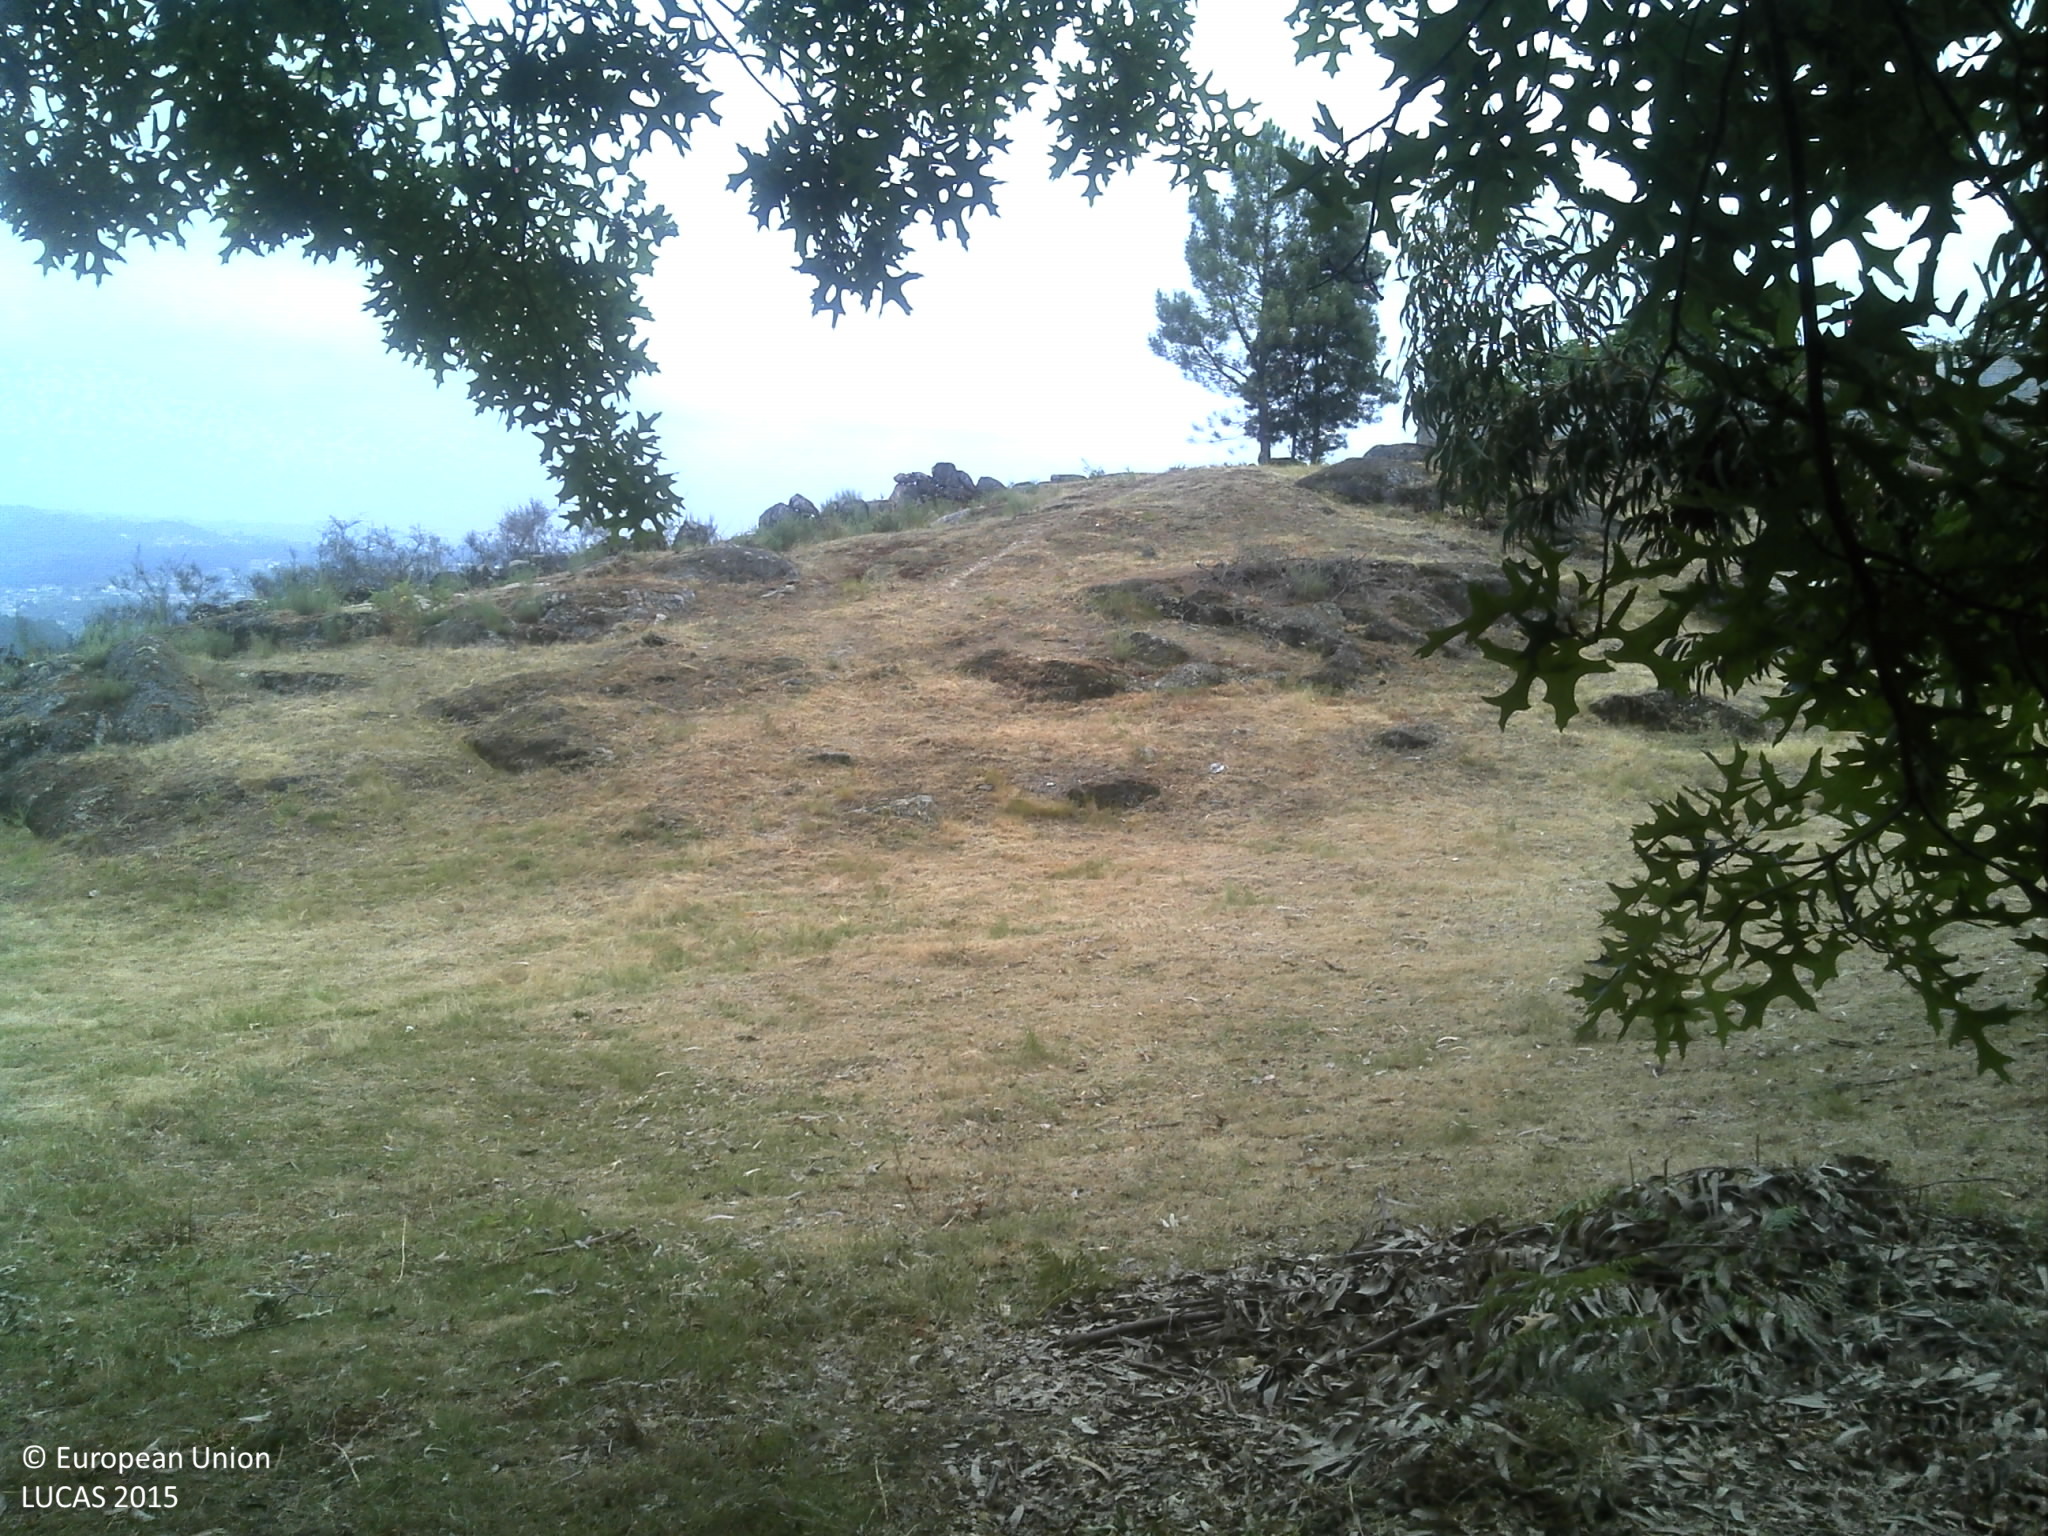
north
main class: Woodland
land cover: Broadleaved woodland
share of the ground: > 75 %
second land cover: Grassland without tree/shrub cover
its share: 10 - 25 %
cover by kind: broadleaved forest trees 75 %, unconsolidated bare surface 15 %, herbaceous plants 10 %
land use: Forestry
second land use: Agriculture (excluding fallow land and kitchen gardens)
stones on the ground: < 10 %
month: June
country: PT
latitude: 41.1602
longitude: -8.1710
